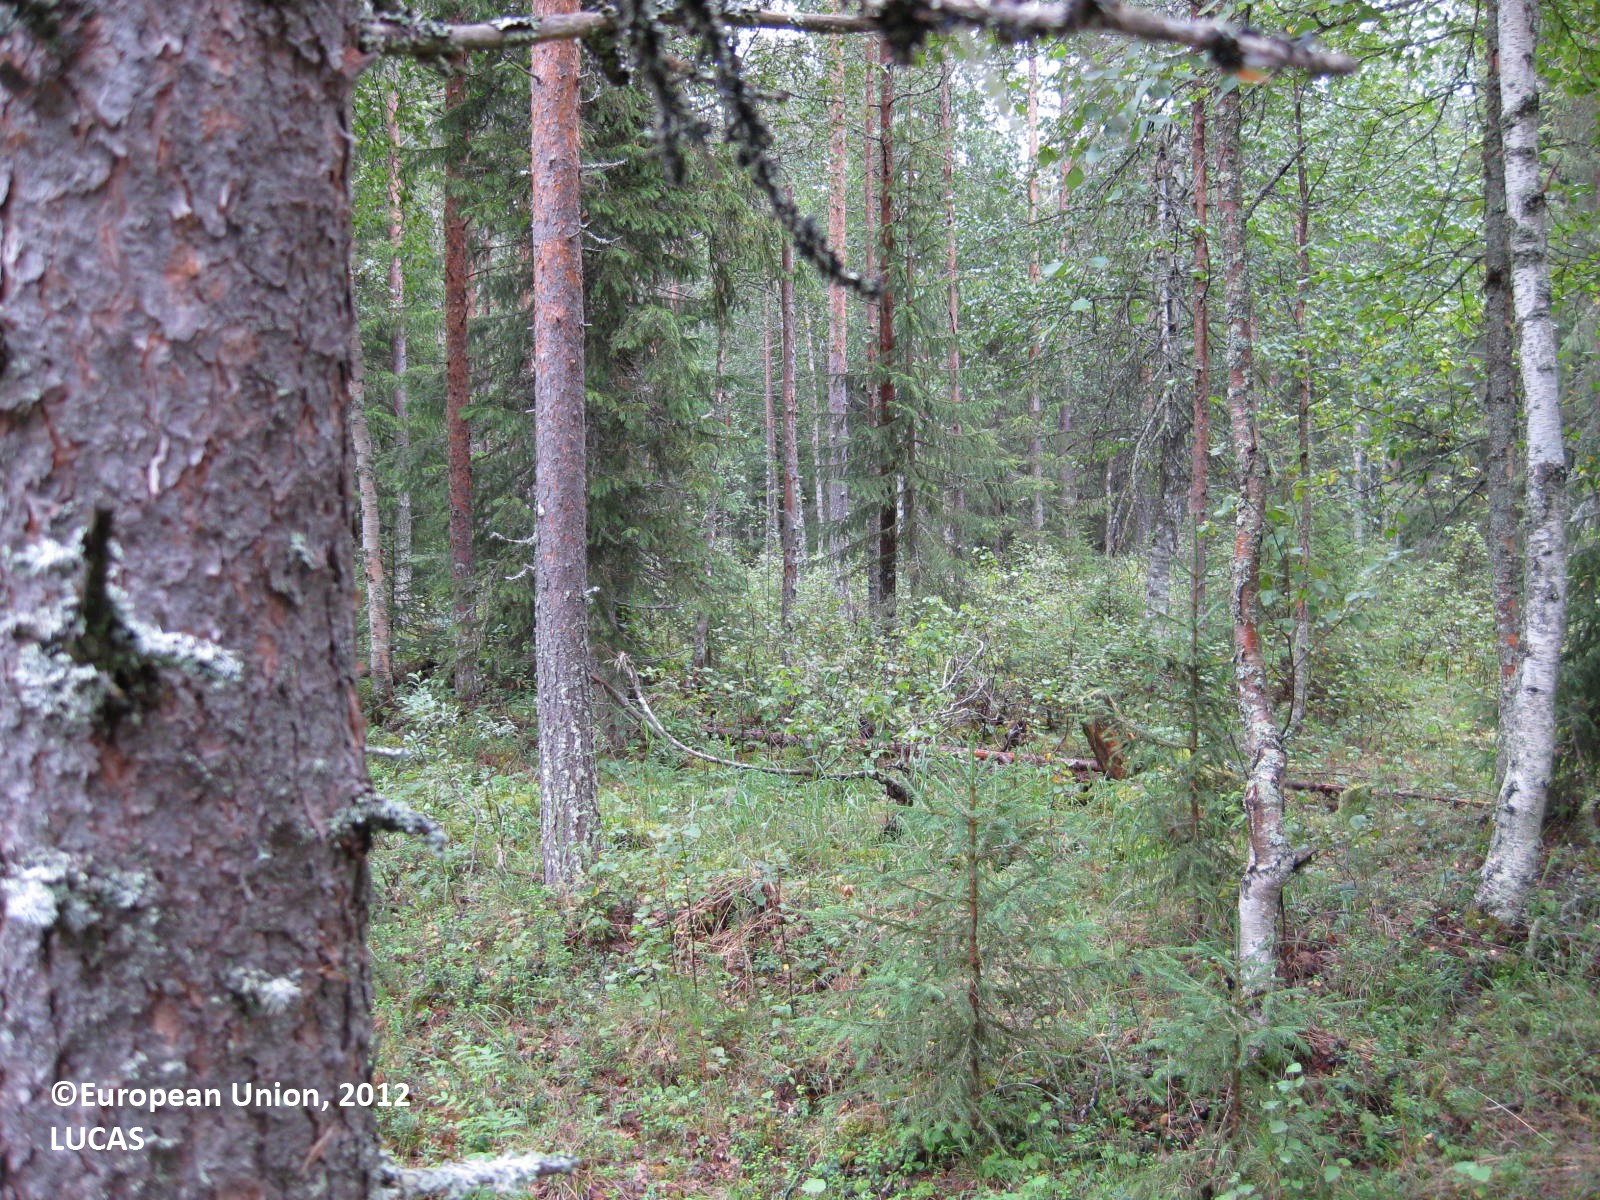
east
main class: Woodland
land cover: Pine dominated mixed woodland
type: boreal forest
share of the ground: 50 - 75 %
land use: Forestry
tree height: > 5 m
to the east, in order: Pine dominated mixed woodland; Other mixed woodland; Ditches and canals; Grass margins; Other mixed woodland; Pine dominated mixed woodland; Abandoned hedges; Ditches and canals; Abandoned hedges; Pine dominated mixed woodland; Spontaneously vegetated surfaces; Pine dominated mixed woodland; Broadleaved woodland
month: August
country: FI
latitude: 65.8812
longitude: 28.1043
